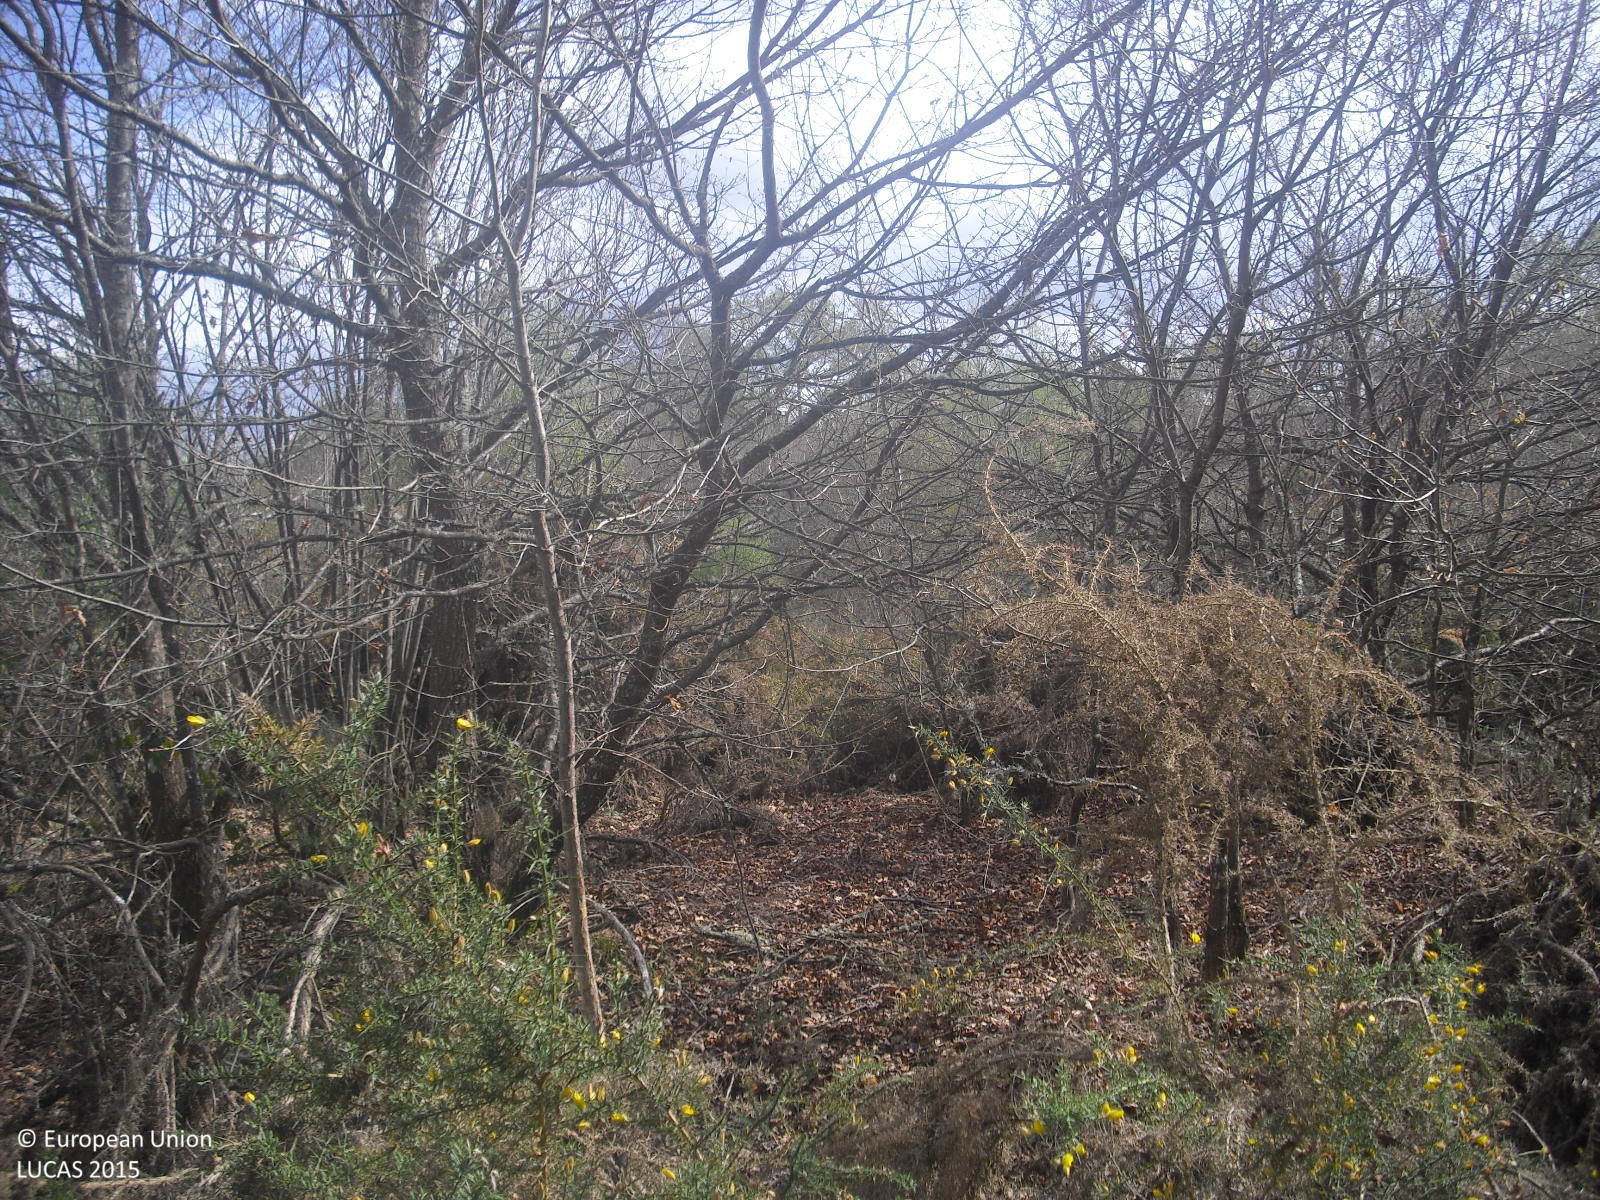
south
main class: Woodland
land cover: Broadleaved woodland
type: acidophilous oak and oak-birch forest
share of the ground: 50 - 75 %
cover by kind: broadleaved forest trees 70 %, shrubs 30 %
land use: Semi-natural and natural areas not in use
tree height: > 5 m
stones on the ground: < 10 %
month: April
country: ES
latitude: 42.0678
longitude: -7.8510
